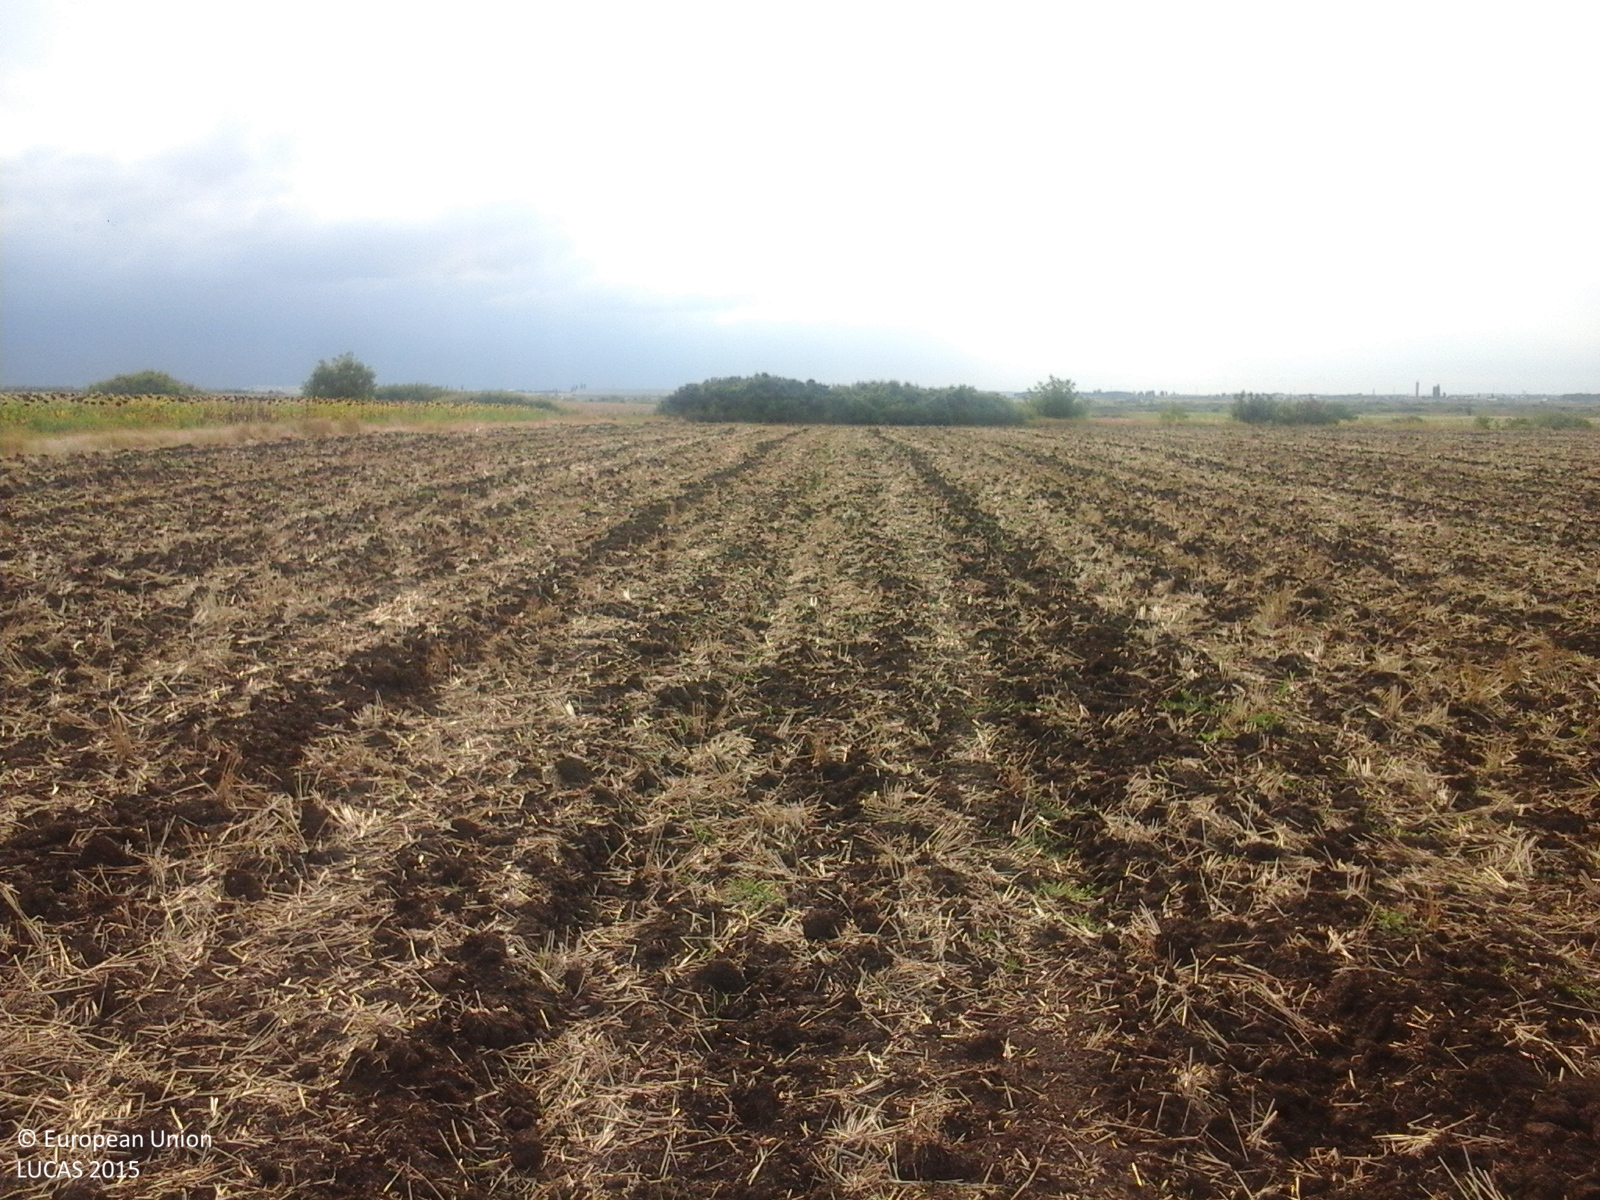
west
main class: Cropland
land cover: Common wheat
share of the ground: 25 - 50 %
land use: Agriculture (excluding fallow land and kitchen gardens)
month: August
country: RO
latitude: 45.8209
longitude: 21.3198
